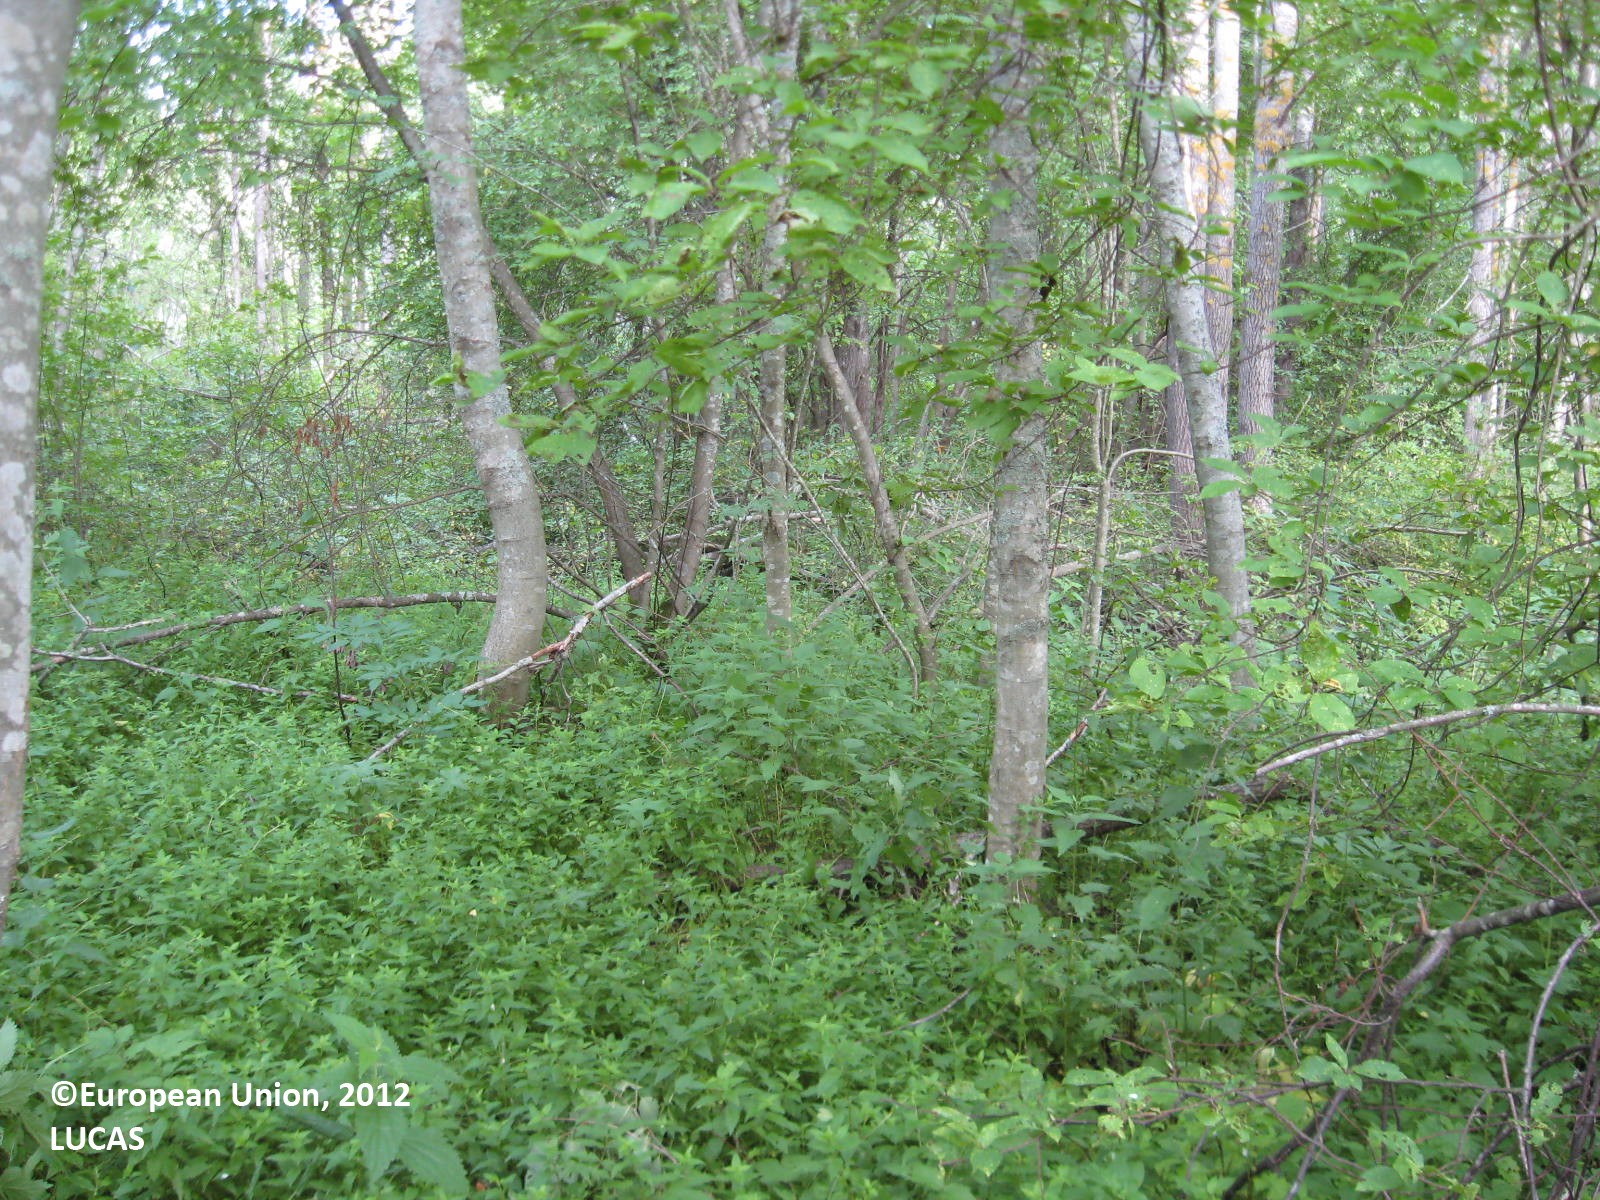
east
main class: Woodland
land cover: Broadleaved woodland
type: boreal forest
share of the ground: > 75 %
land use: Semi-natural and natural areas not in use
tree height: > 5 m
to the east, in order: Broadleaved woodland; Shrubland without tree cover; Electric lines; Shrubland without tree cover; Other mixed woodland; Ditches and canals; Other coniferous woodland; Broadleaved woodland; Inland running water; Broadleaved woodland; Rape and turnip rape
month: July
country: FI
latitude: 62.2347
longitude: 21.6109
